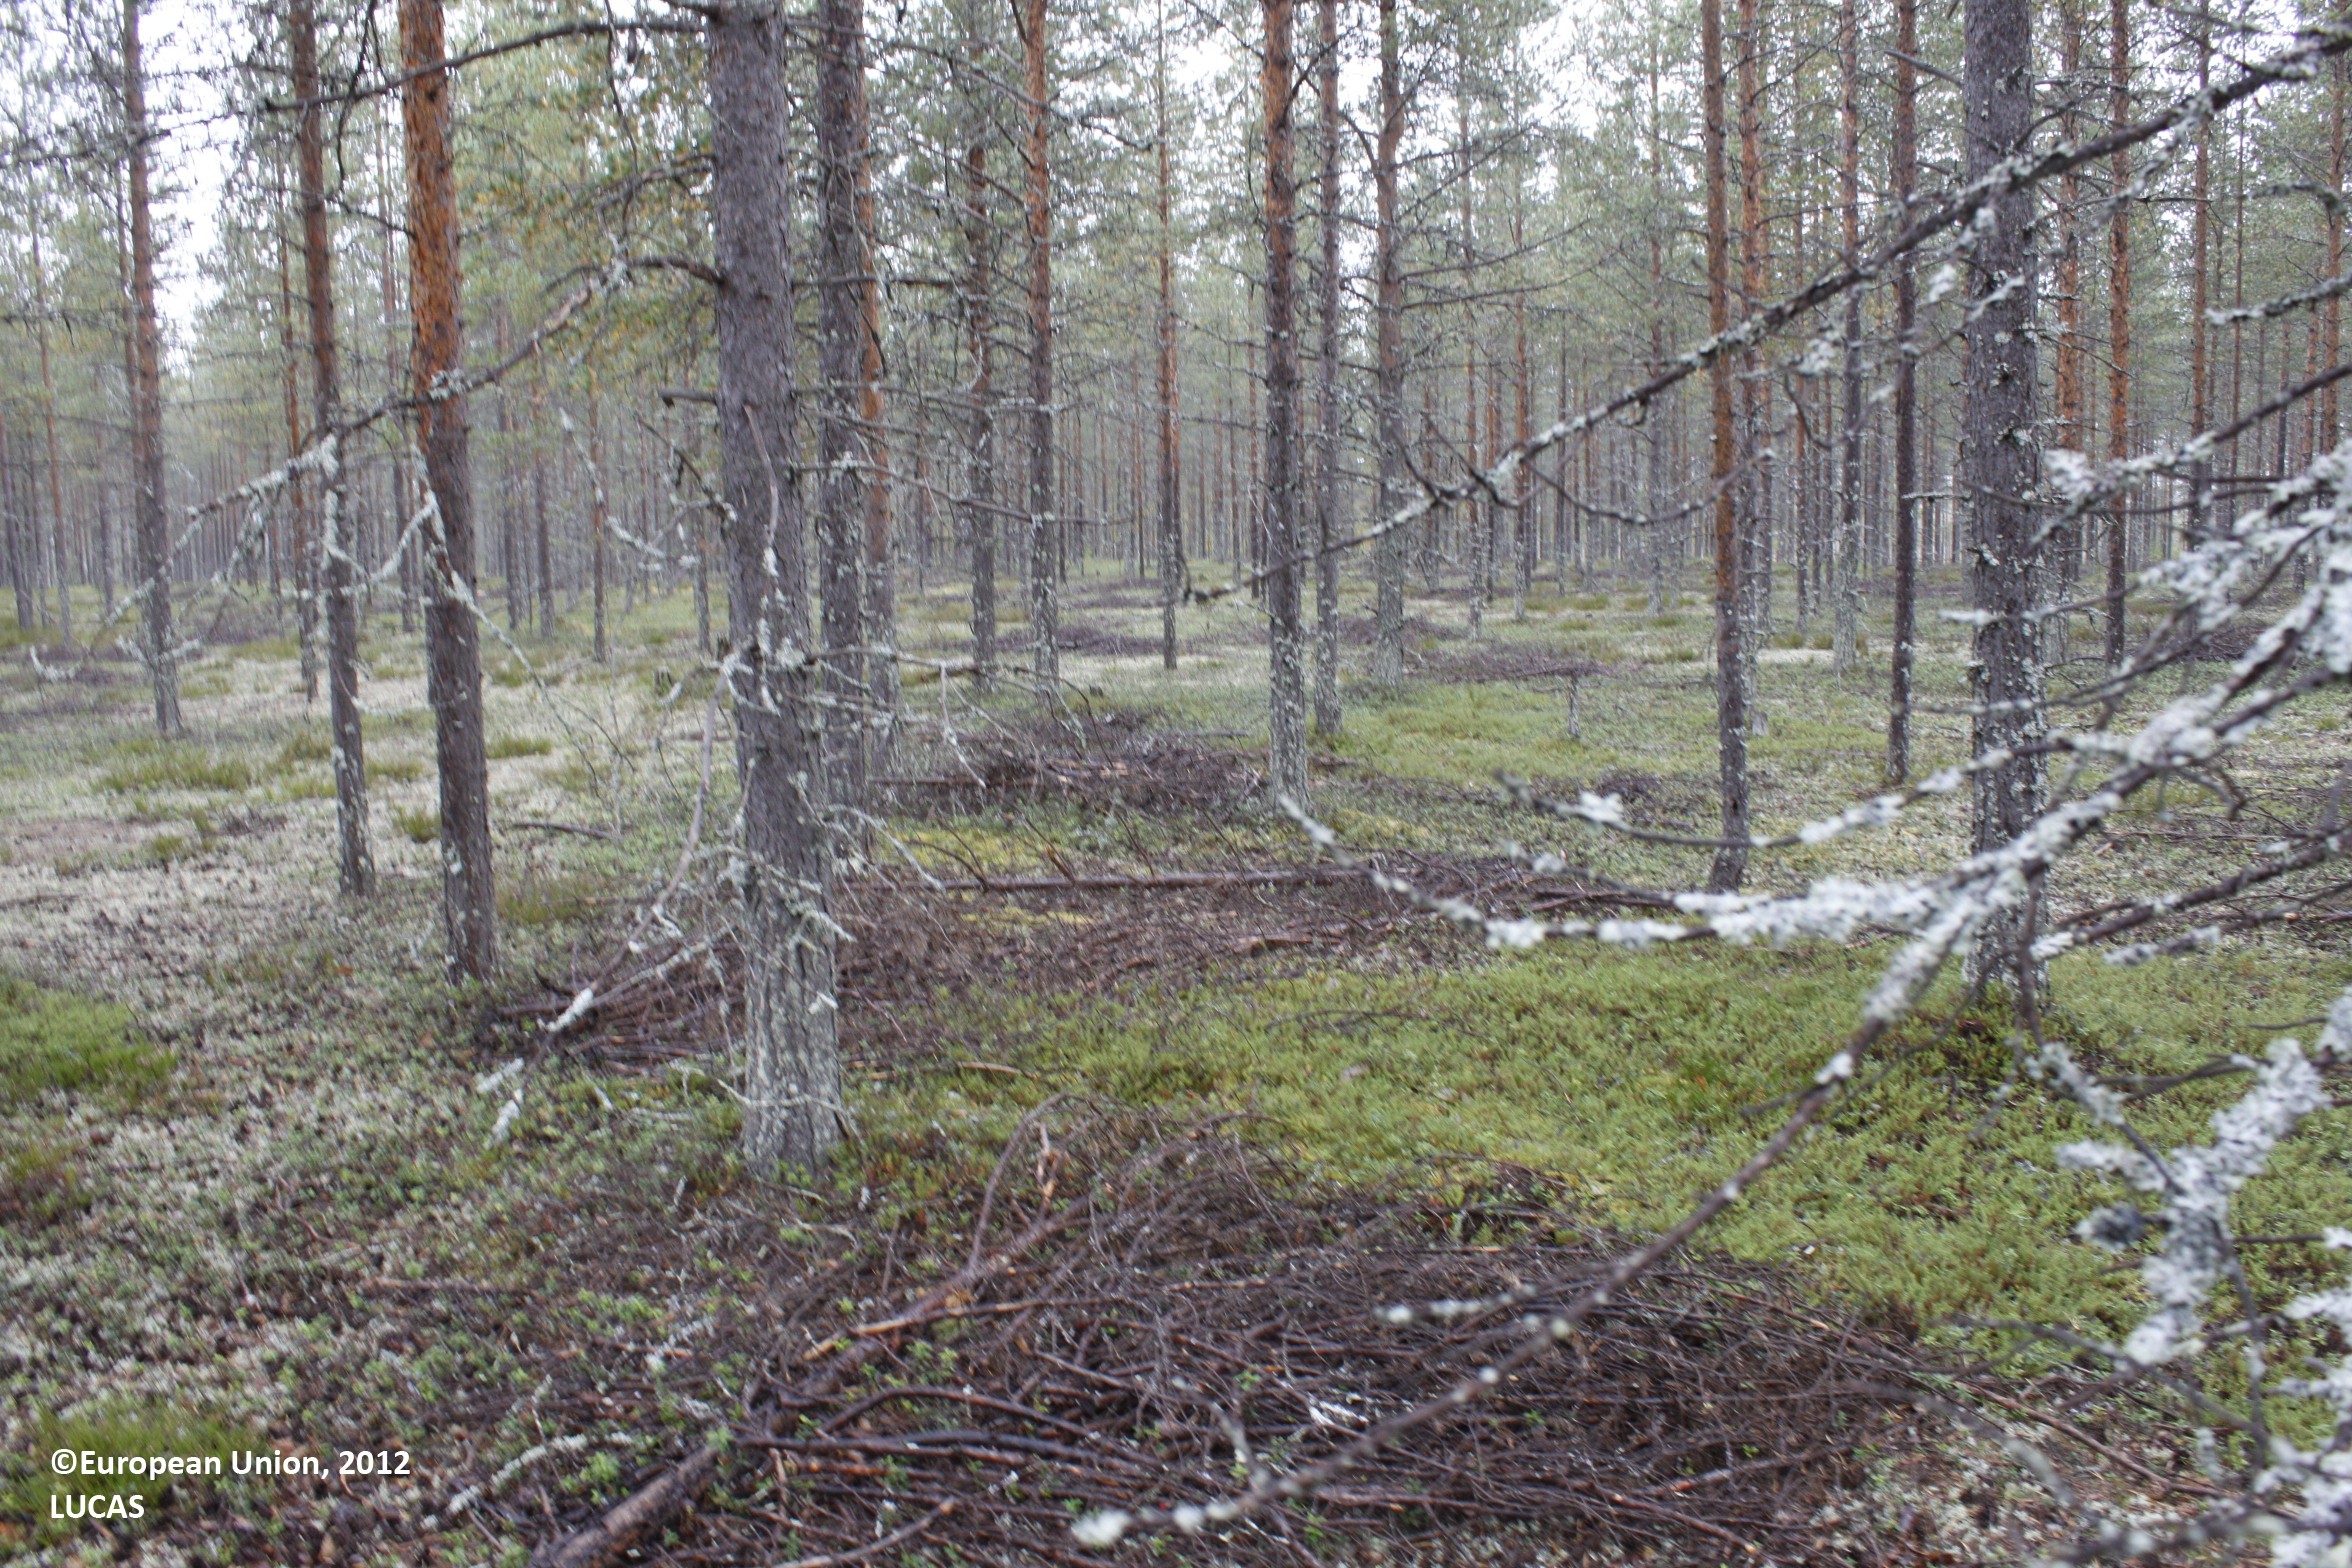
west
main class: Woodland
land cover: Pine dominated coniferous woodland
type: mire and swamp forests
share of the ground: 25 - 50 %
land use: Forestry
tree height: > 5 m
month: September
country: FI
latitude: 65.3928
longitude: 26.9237
